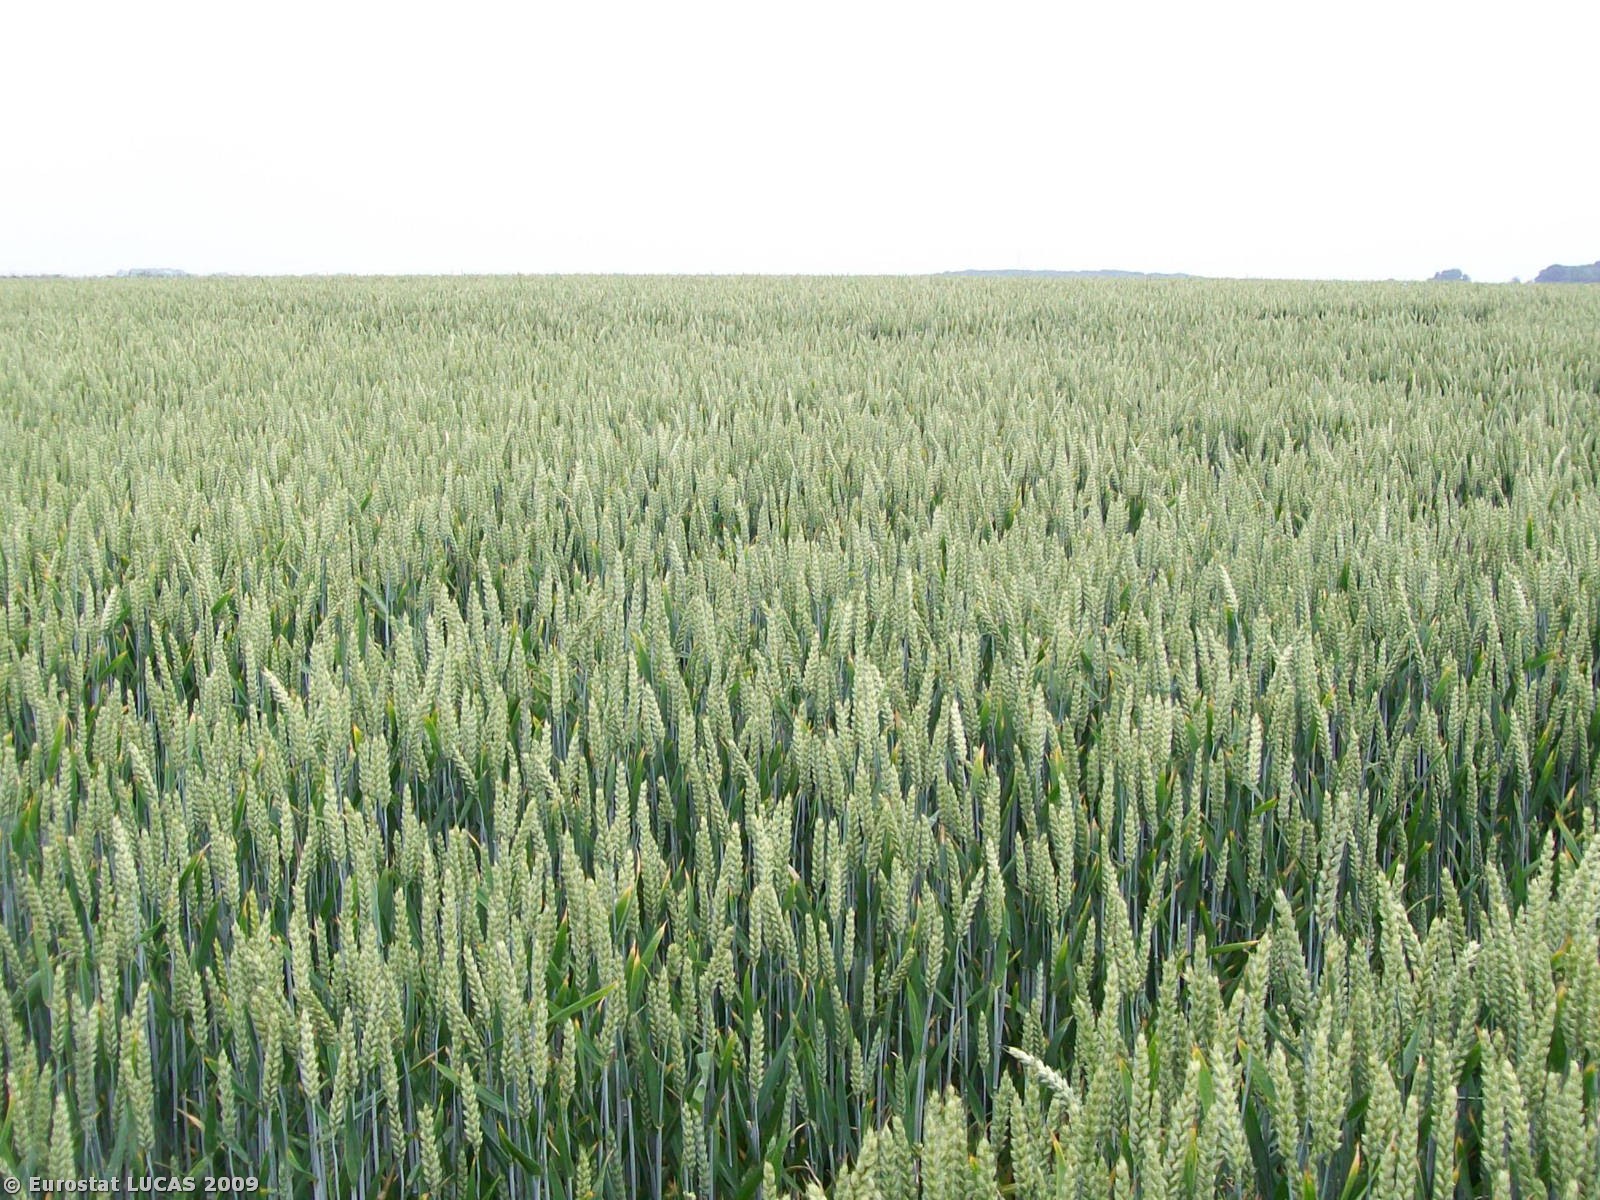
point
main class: Cropland
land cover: Common wheat
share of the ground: < 10 %
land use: Agriculture (excluding fallow land and kitchen gardens)
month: June
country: GB
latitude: 54.1995
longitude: -1.4687
